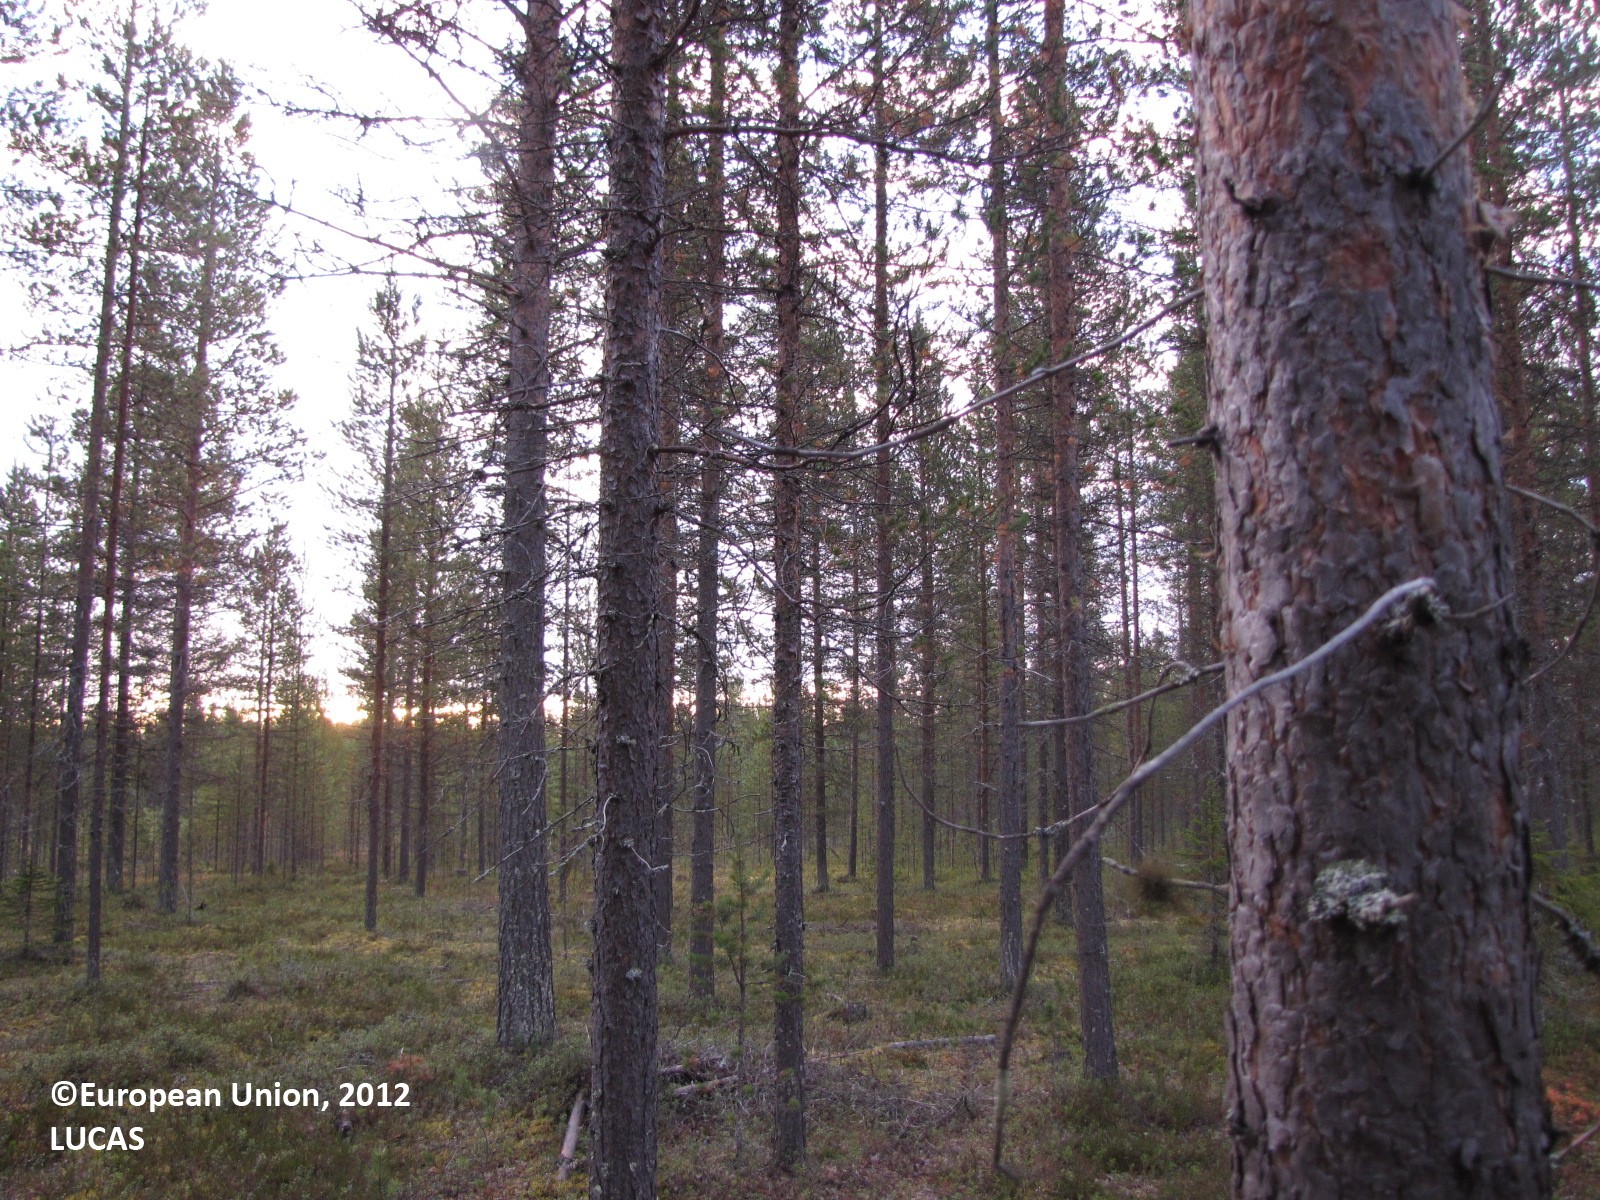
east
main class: Woodland
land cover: Pine dominated coniferous woodland
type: boreal forest
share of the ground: 50 - 75 %
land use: Forestry
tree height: > 5 m
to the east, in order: Pine dominated coniferous woodland; Grassland with sparse tree/shrub cover; Paved roads, cycling and walking lanes; Pine dominated coniferous woodland
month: September
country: FI
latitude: 67.3139
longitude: 24.8870
